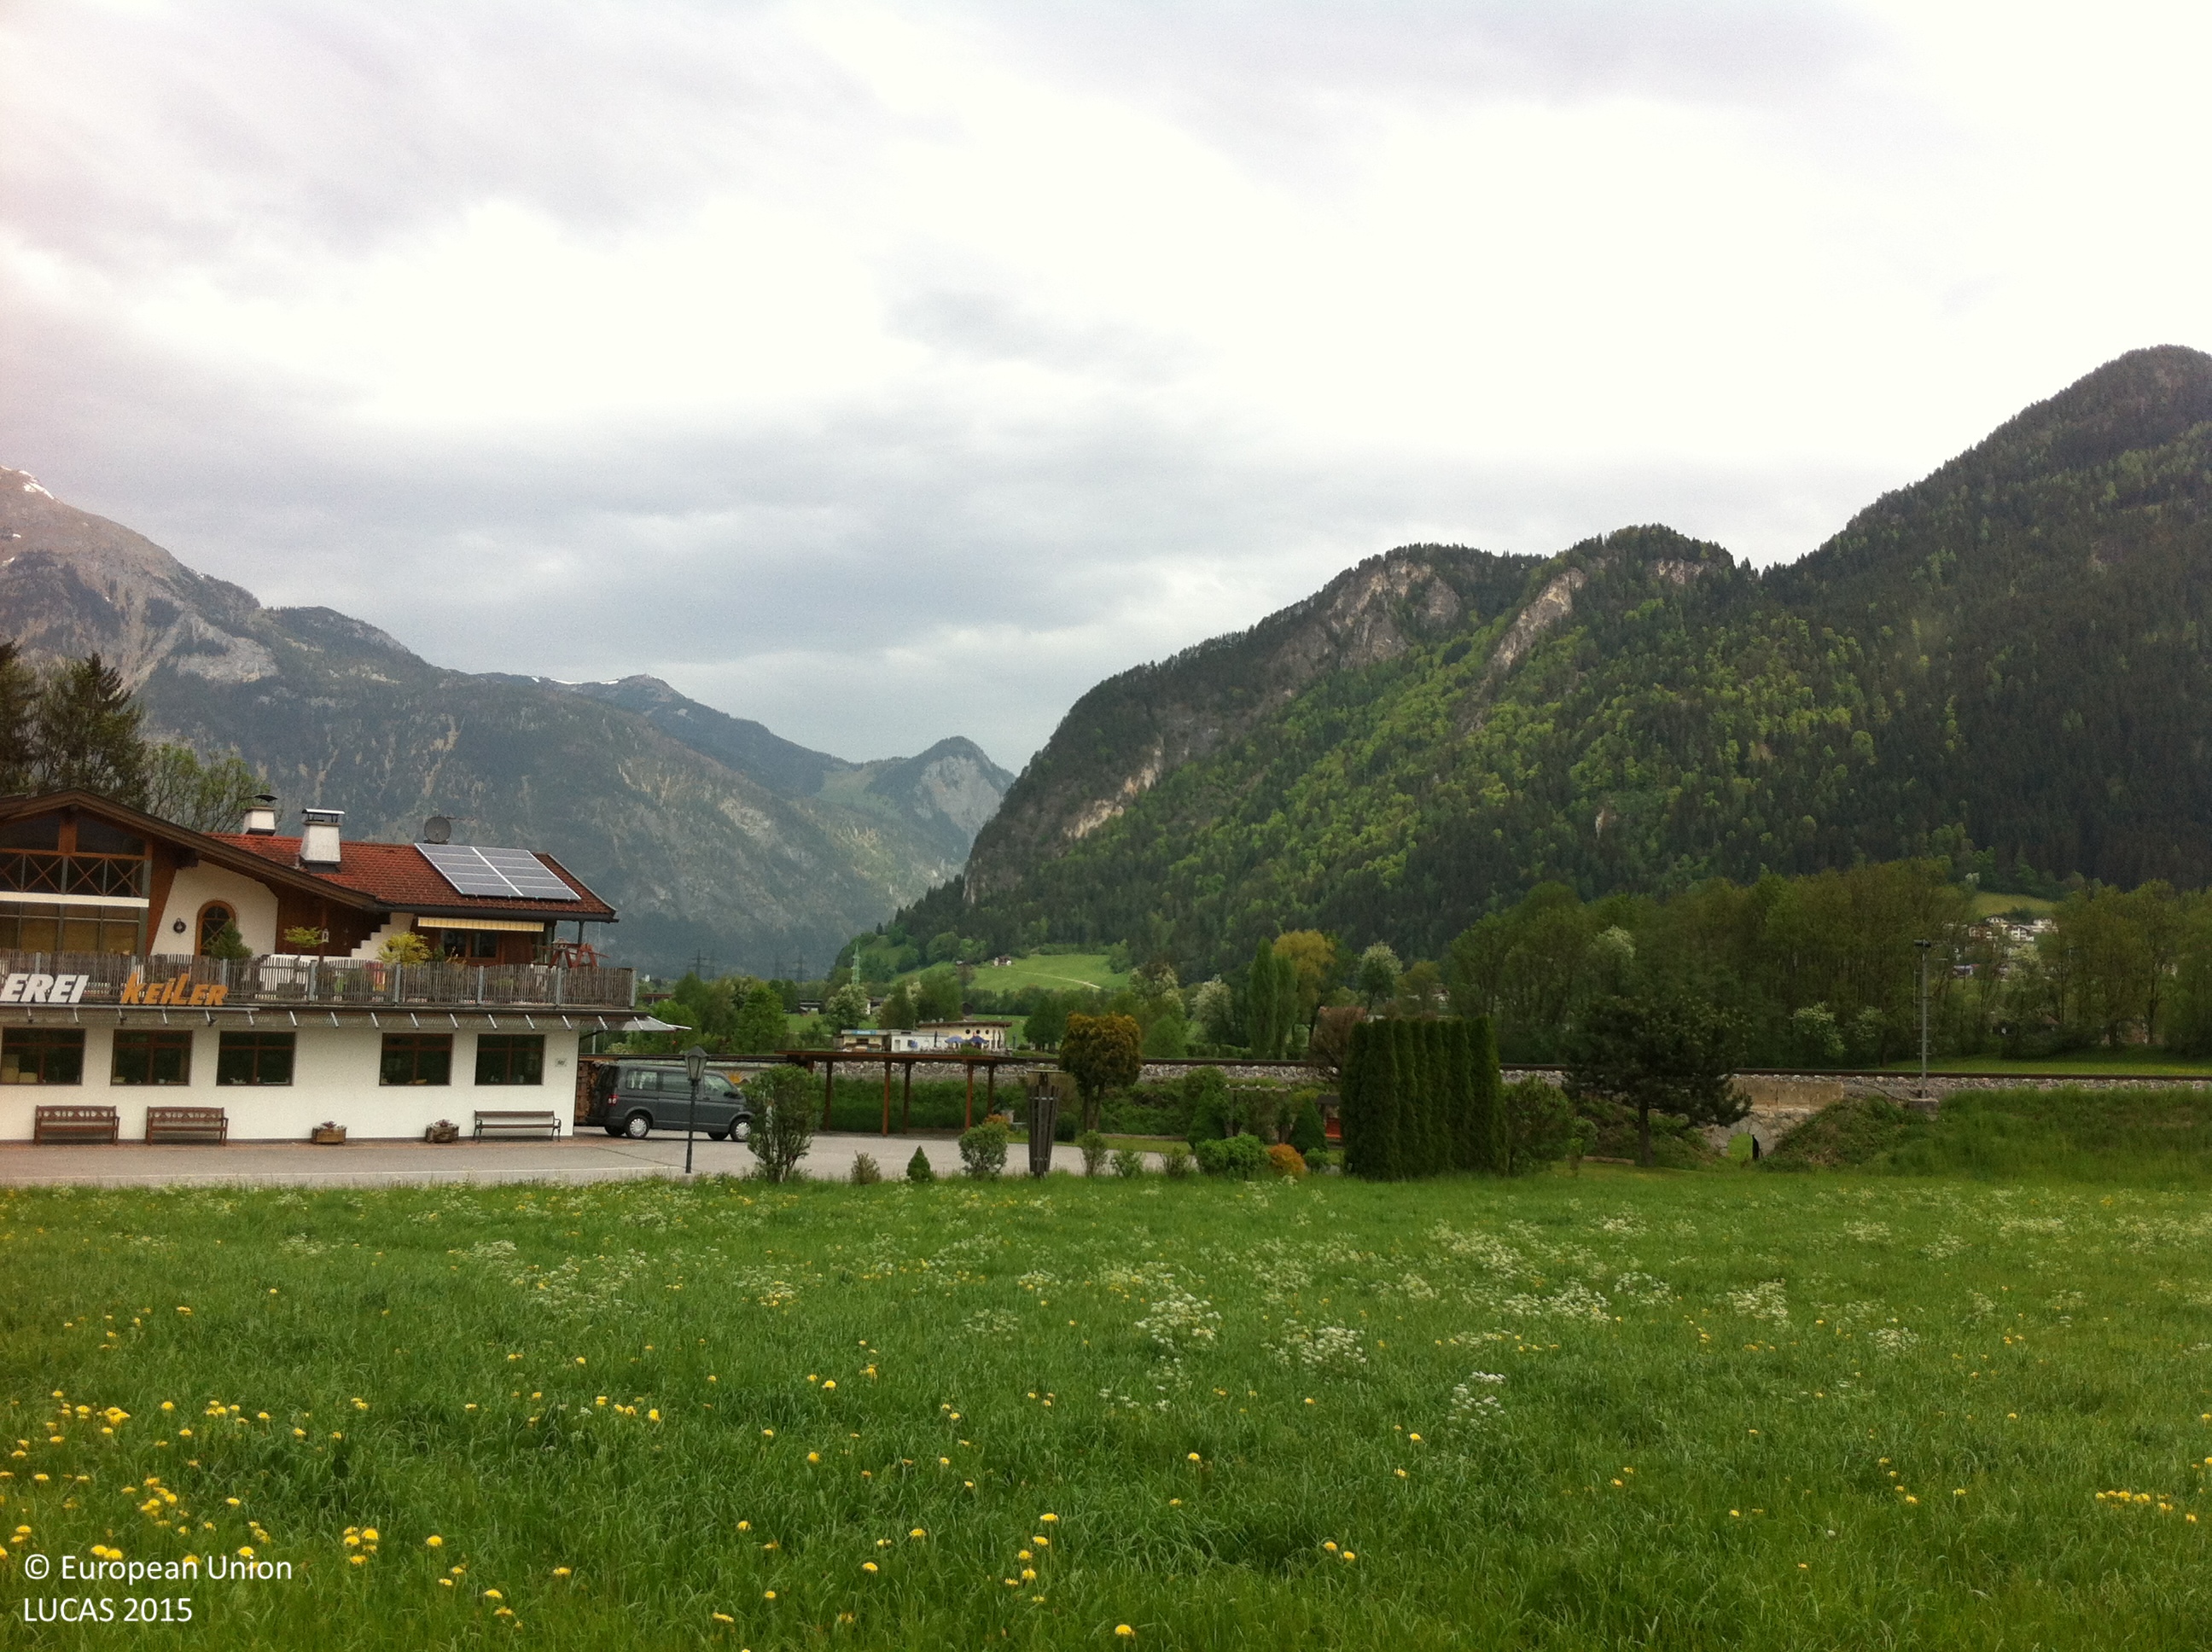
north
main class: Grassland
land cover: Grassland without tree/shrub cover
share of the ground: > 75 %
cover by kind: herbaceous plants 100 %
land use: Agriculture (excluding fallow land and kitchen gardens)
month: May
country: AT
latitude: 47.3801
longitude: 11.8396
